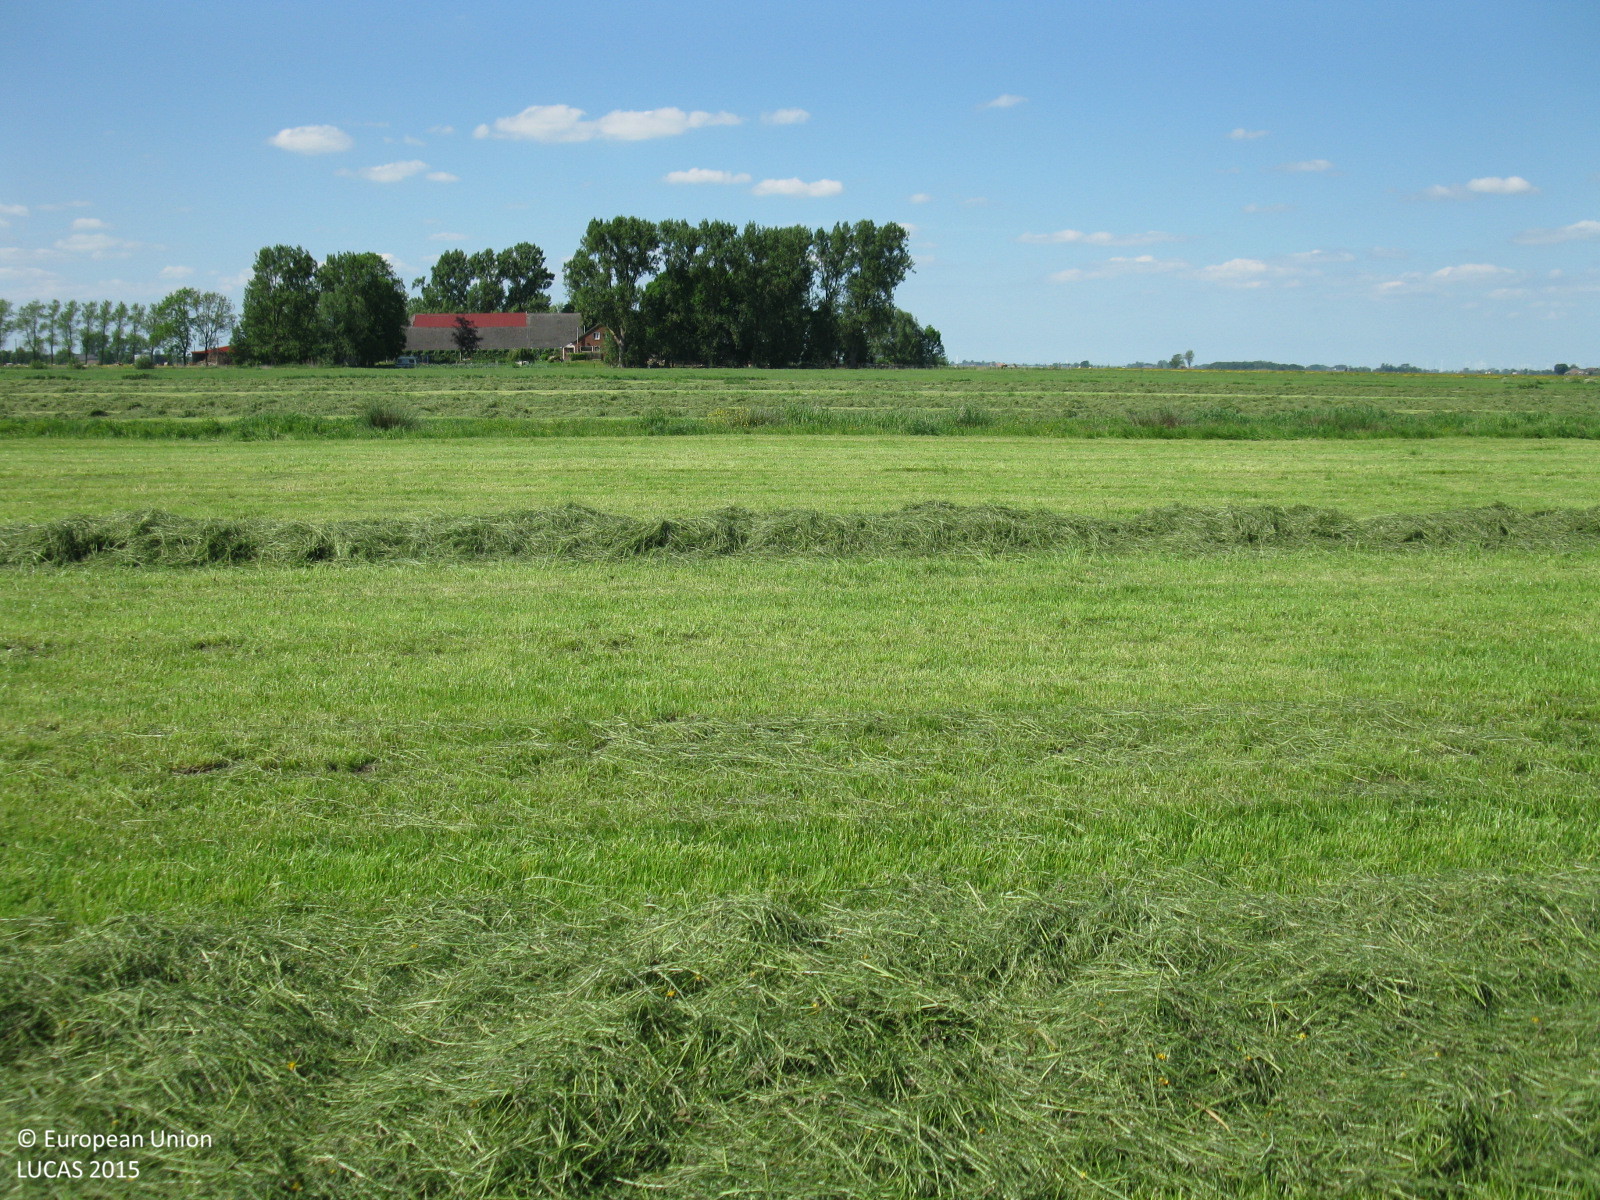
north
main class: Grassland
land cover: Grassland without tree/shrub cover
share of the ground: > 75 %
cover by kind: herbaceous plants 100 %
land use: Agriculture (excluding fallow land and kitchen gardens)
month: June
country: DE
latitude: 53.2457
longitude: 7.2881
